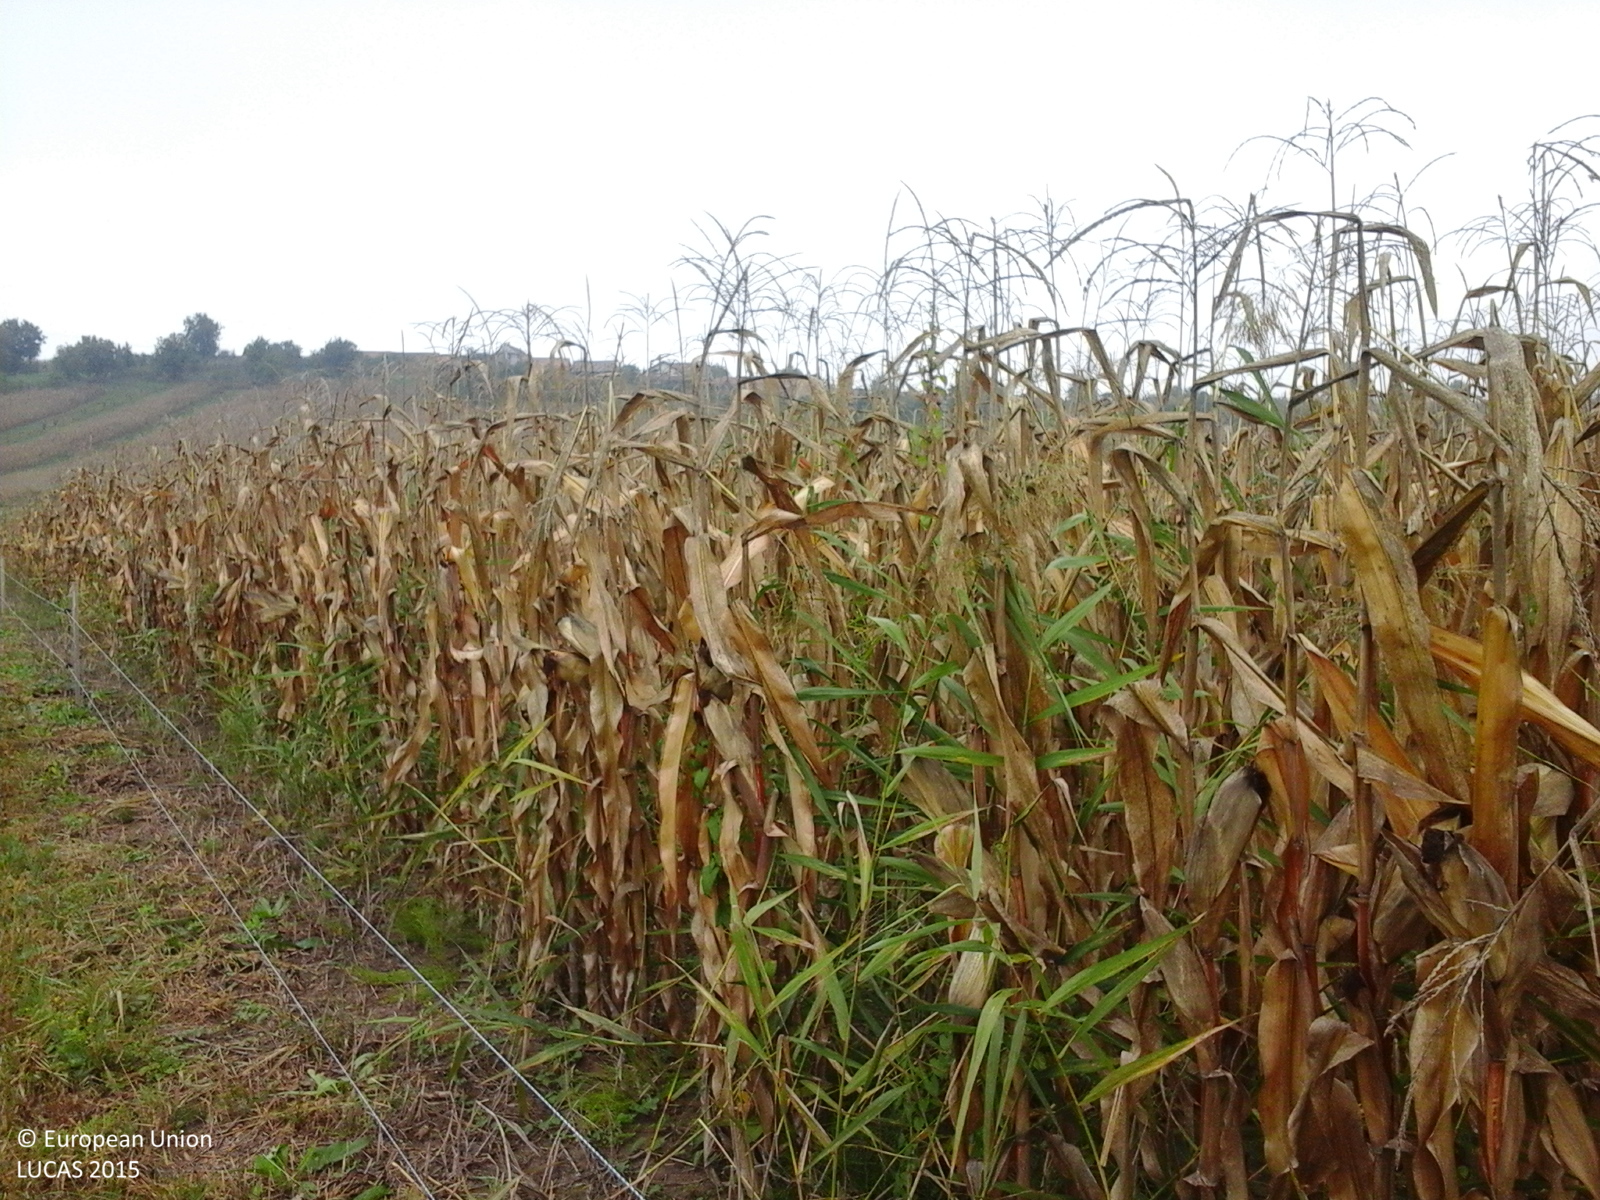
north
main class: Cropland
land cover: Maize
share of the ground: > 75 %
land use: Agriculture (excluding fallow land and kitchen gardens)
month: October
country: RO
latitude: 46.2419
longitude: 24.1759
